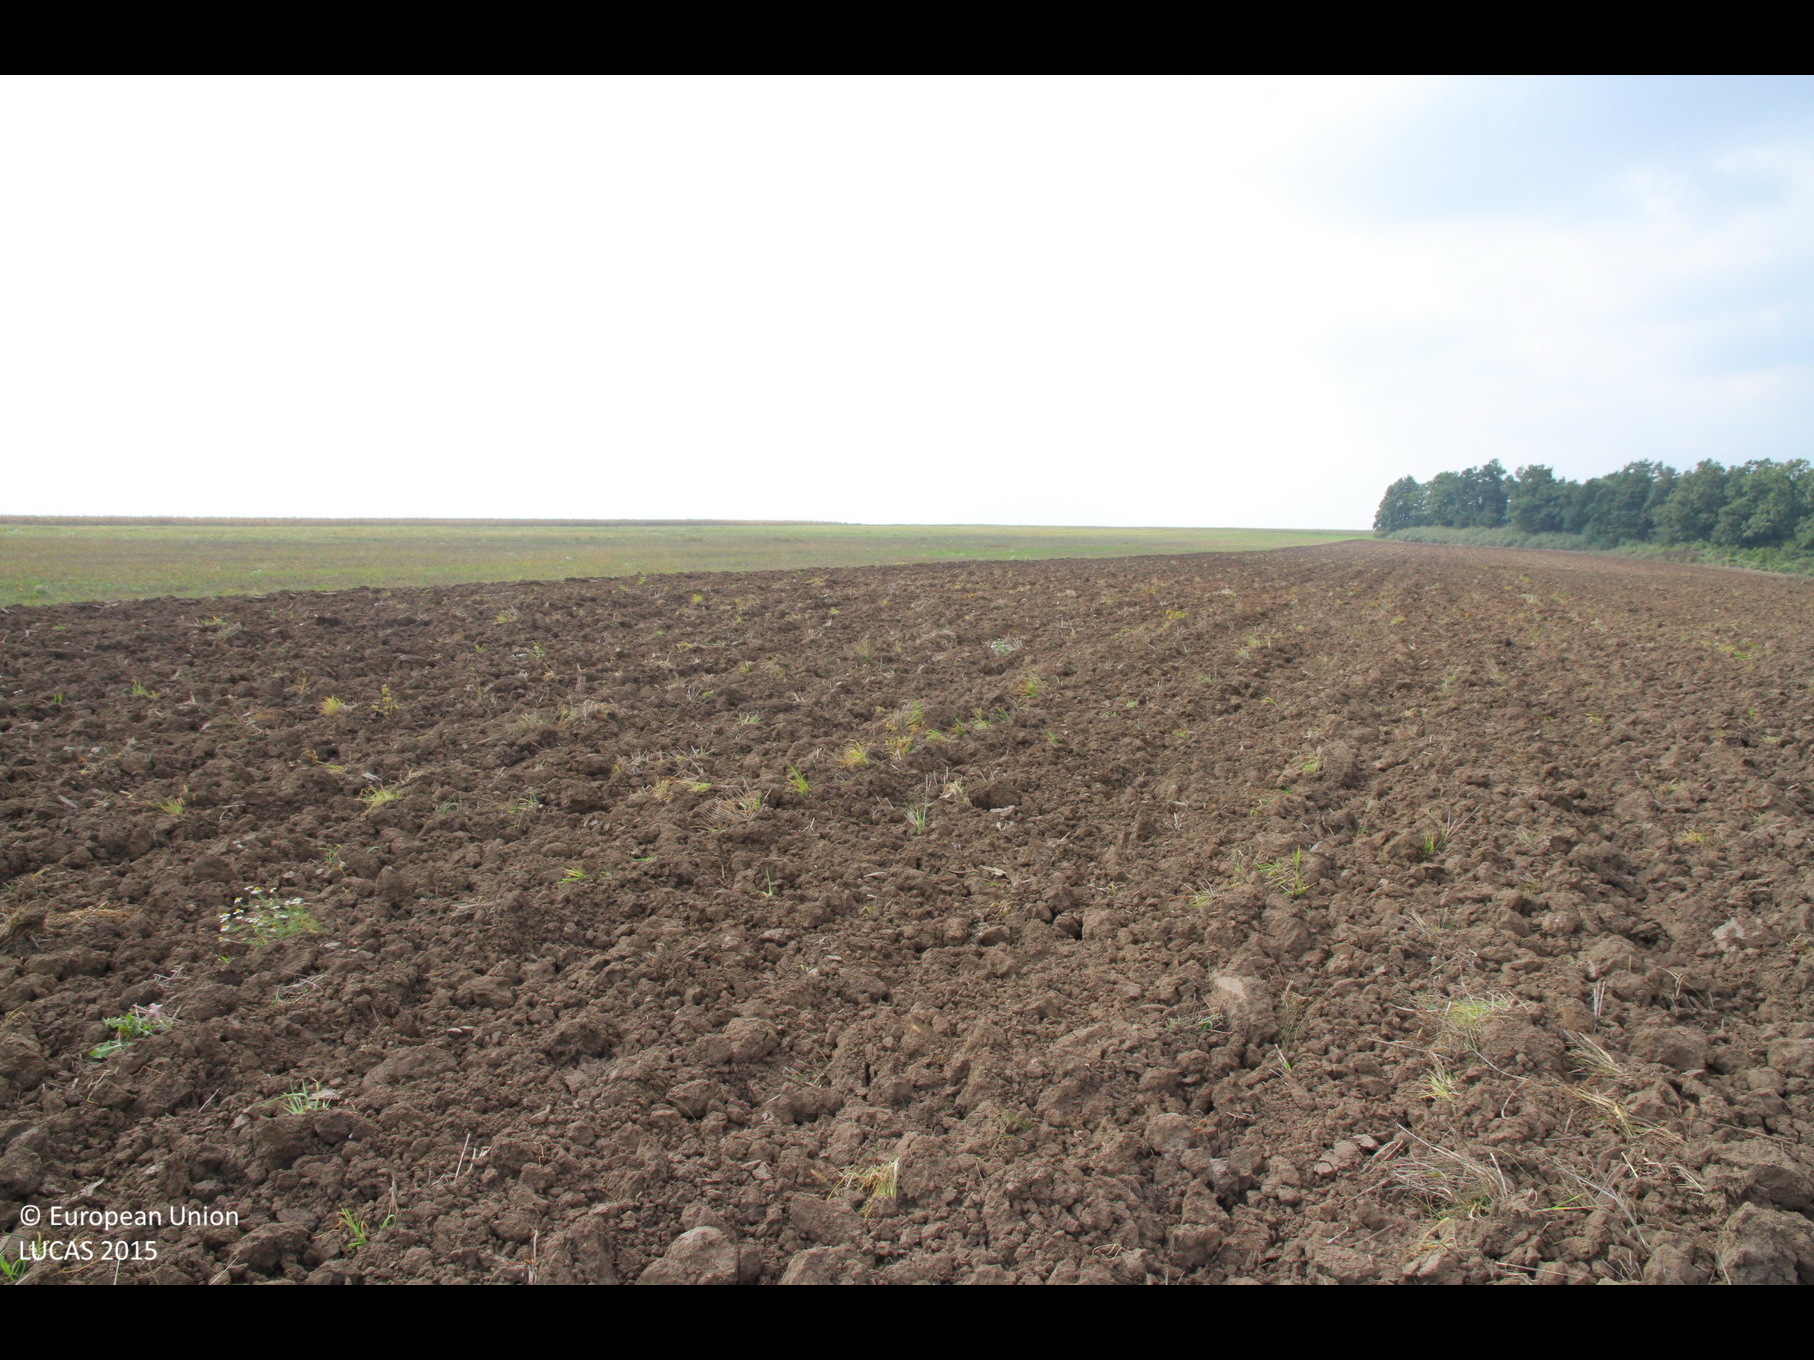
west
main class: Cropland
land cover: Common wheat
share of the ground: < 10 %
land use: Agriculture (excluding fallow land and kitchen gardens)
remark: Harvested field
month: October
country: BG
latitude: 43.6066
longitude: 27.0564
